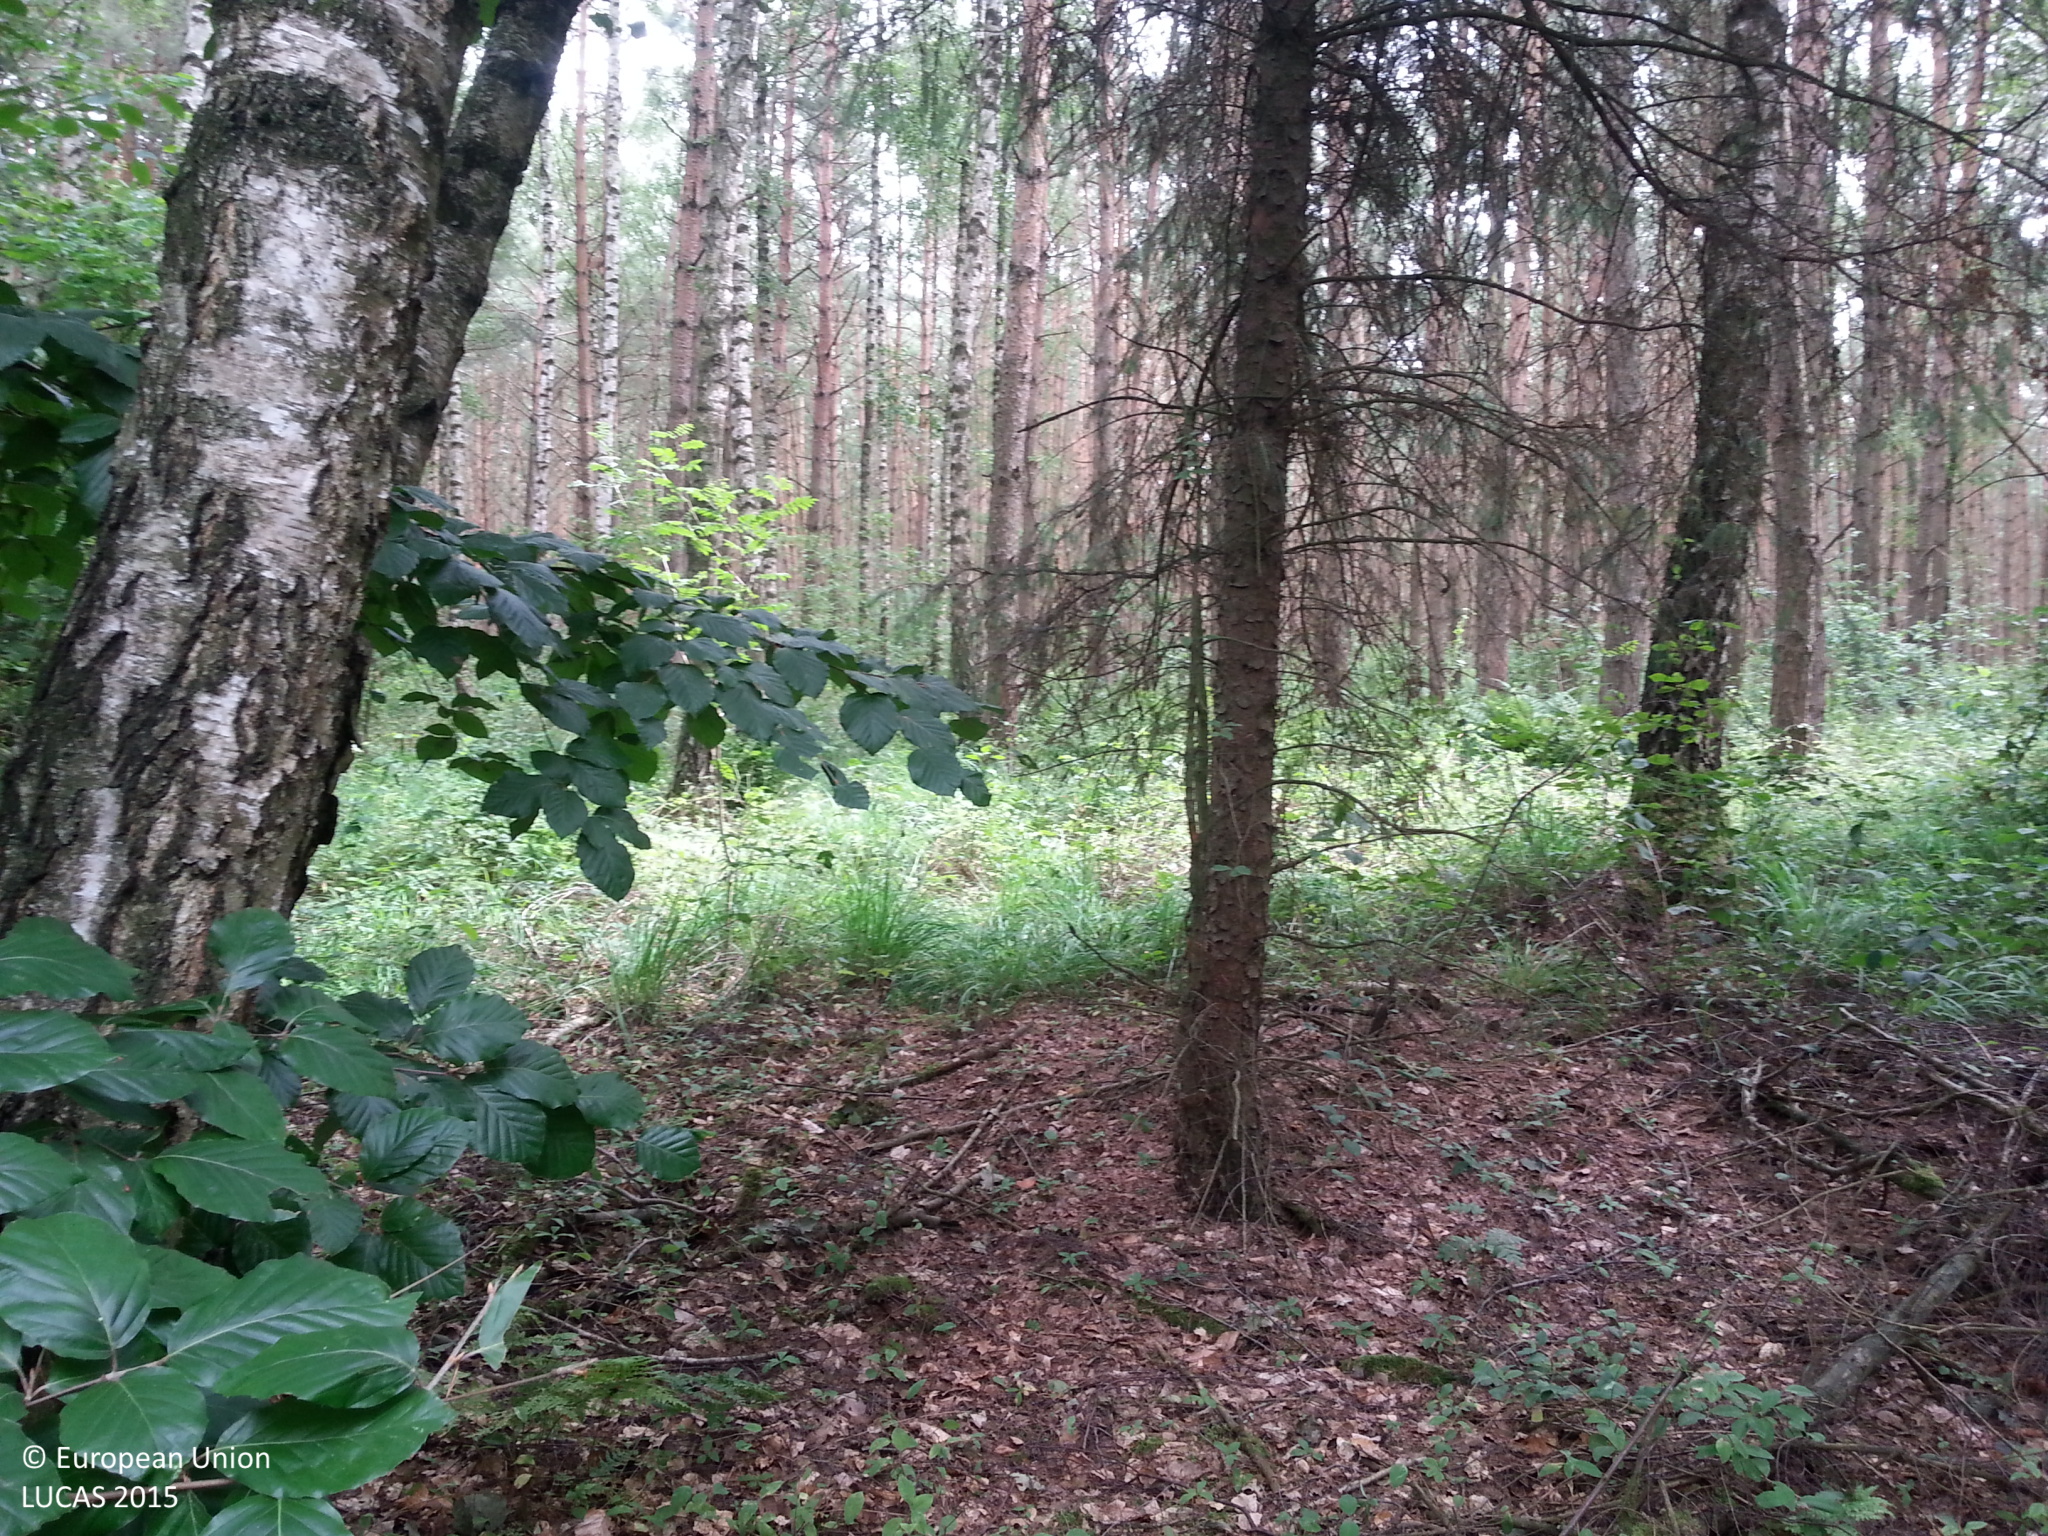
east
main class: Woodland
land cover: Pine dominated mixed woodland
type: hemiboreal forest and nemoral coniferous forest and mixed broadleaved-coniferous forest
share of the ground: 50 - 75 %
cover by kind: coniferous forest trees 45 %, broadleaved forest trees 25 %, shrubs 20 %, herbaceous plants 5 %, unconsolidated bare surface 5 %
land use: Forestry
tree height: > 5 m
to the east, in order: Pine dominated mixed woodland; Pine dominated coniferous woodland
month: July
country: DE
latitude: 53.5401
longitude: 11.1614
